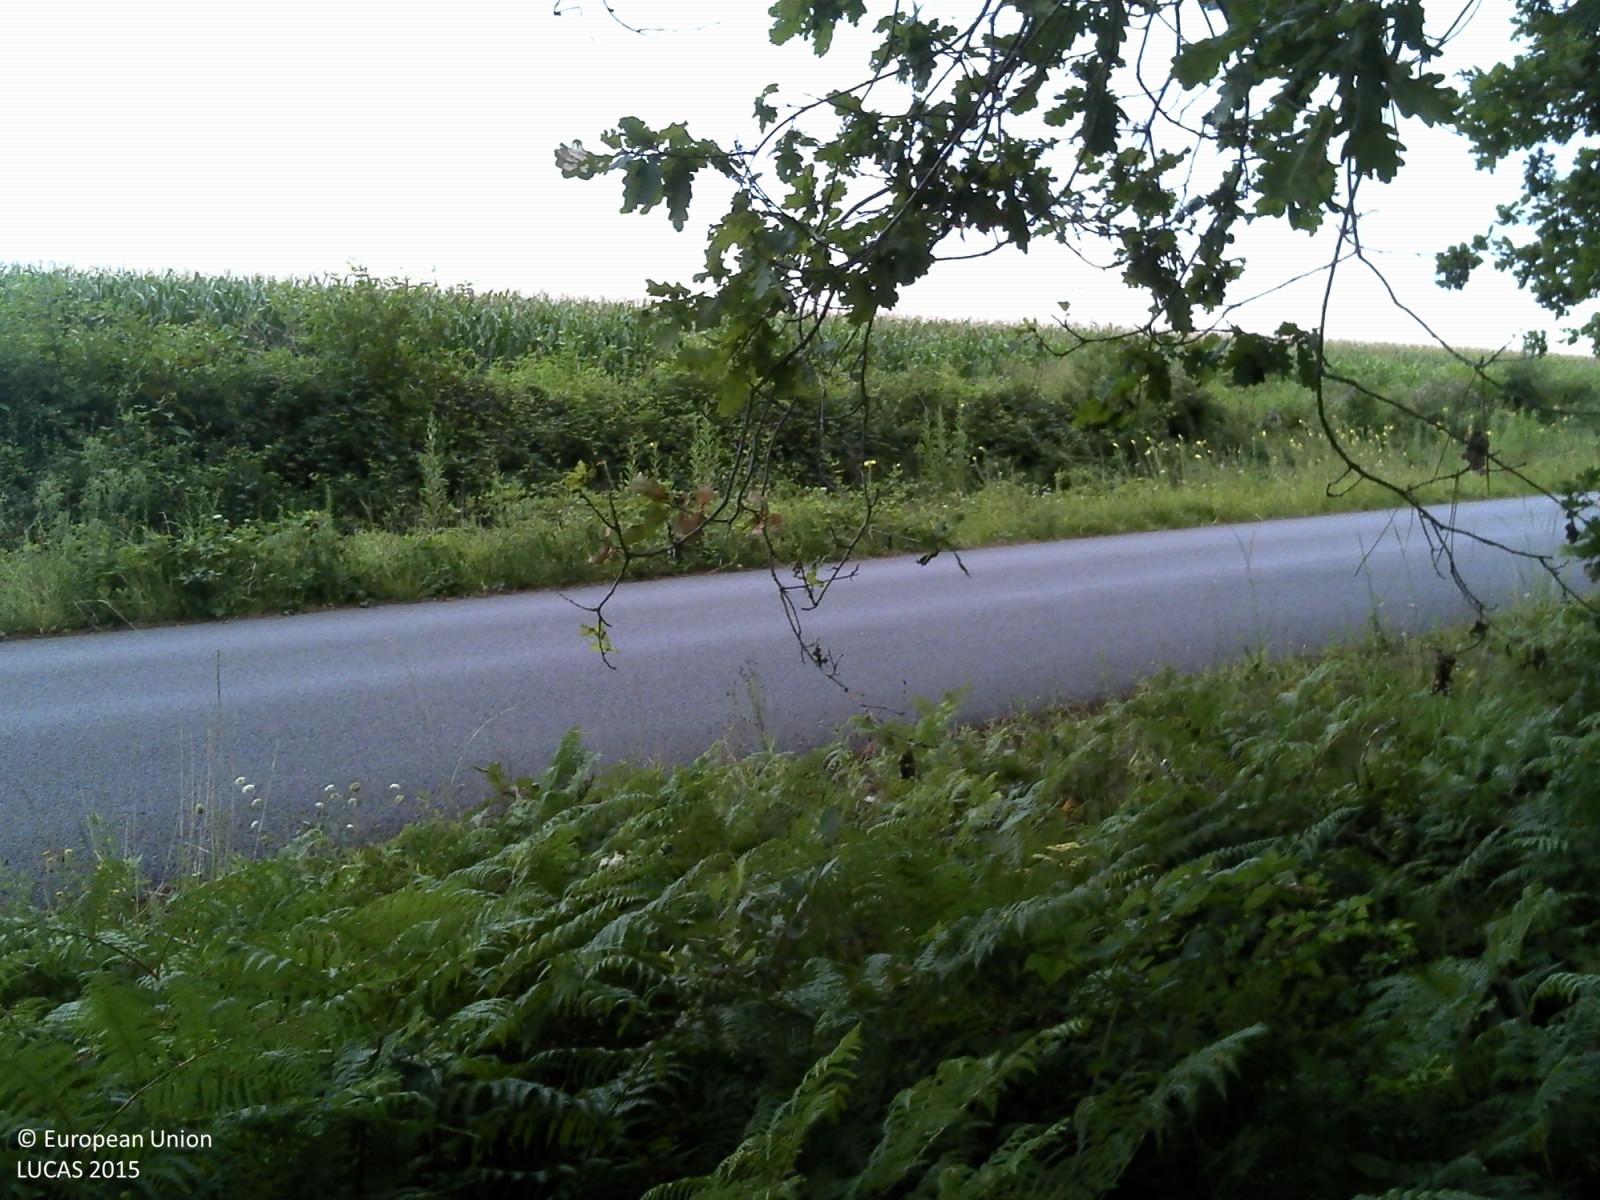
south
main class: Woodland
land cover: Pine dominated coniferous woodland
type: coniferous forest of the mediterranean region
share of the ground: > 75 %
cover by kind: coniferous forest trees 60 %, shrubs 30 %, herbaceous plants 5 %, lichens and mosses 5 %
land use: Forestry
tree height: > 5 m
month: August
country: FR
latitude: 44.7011
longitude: -0.7339
